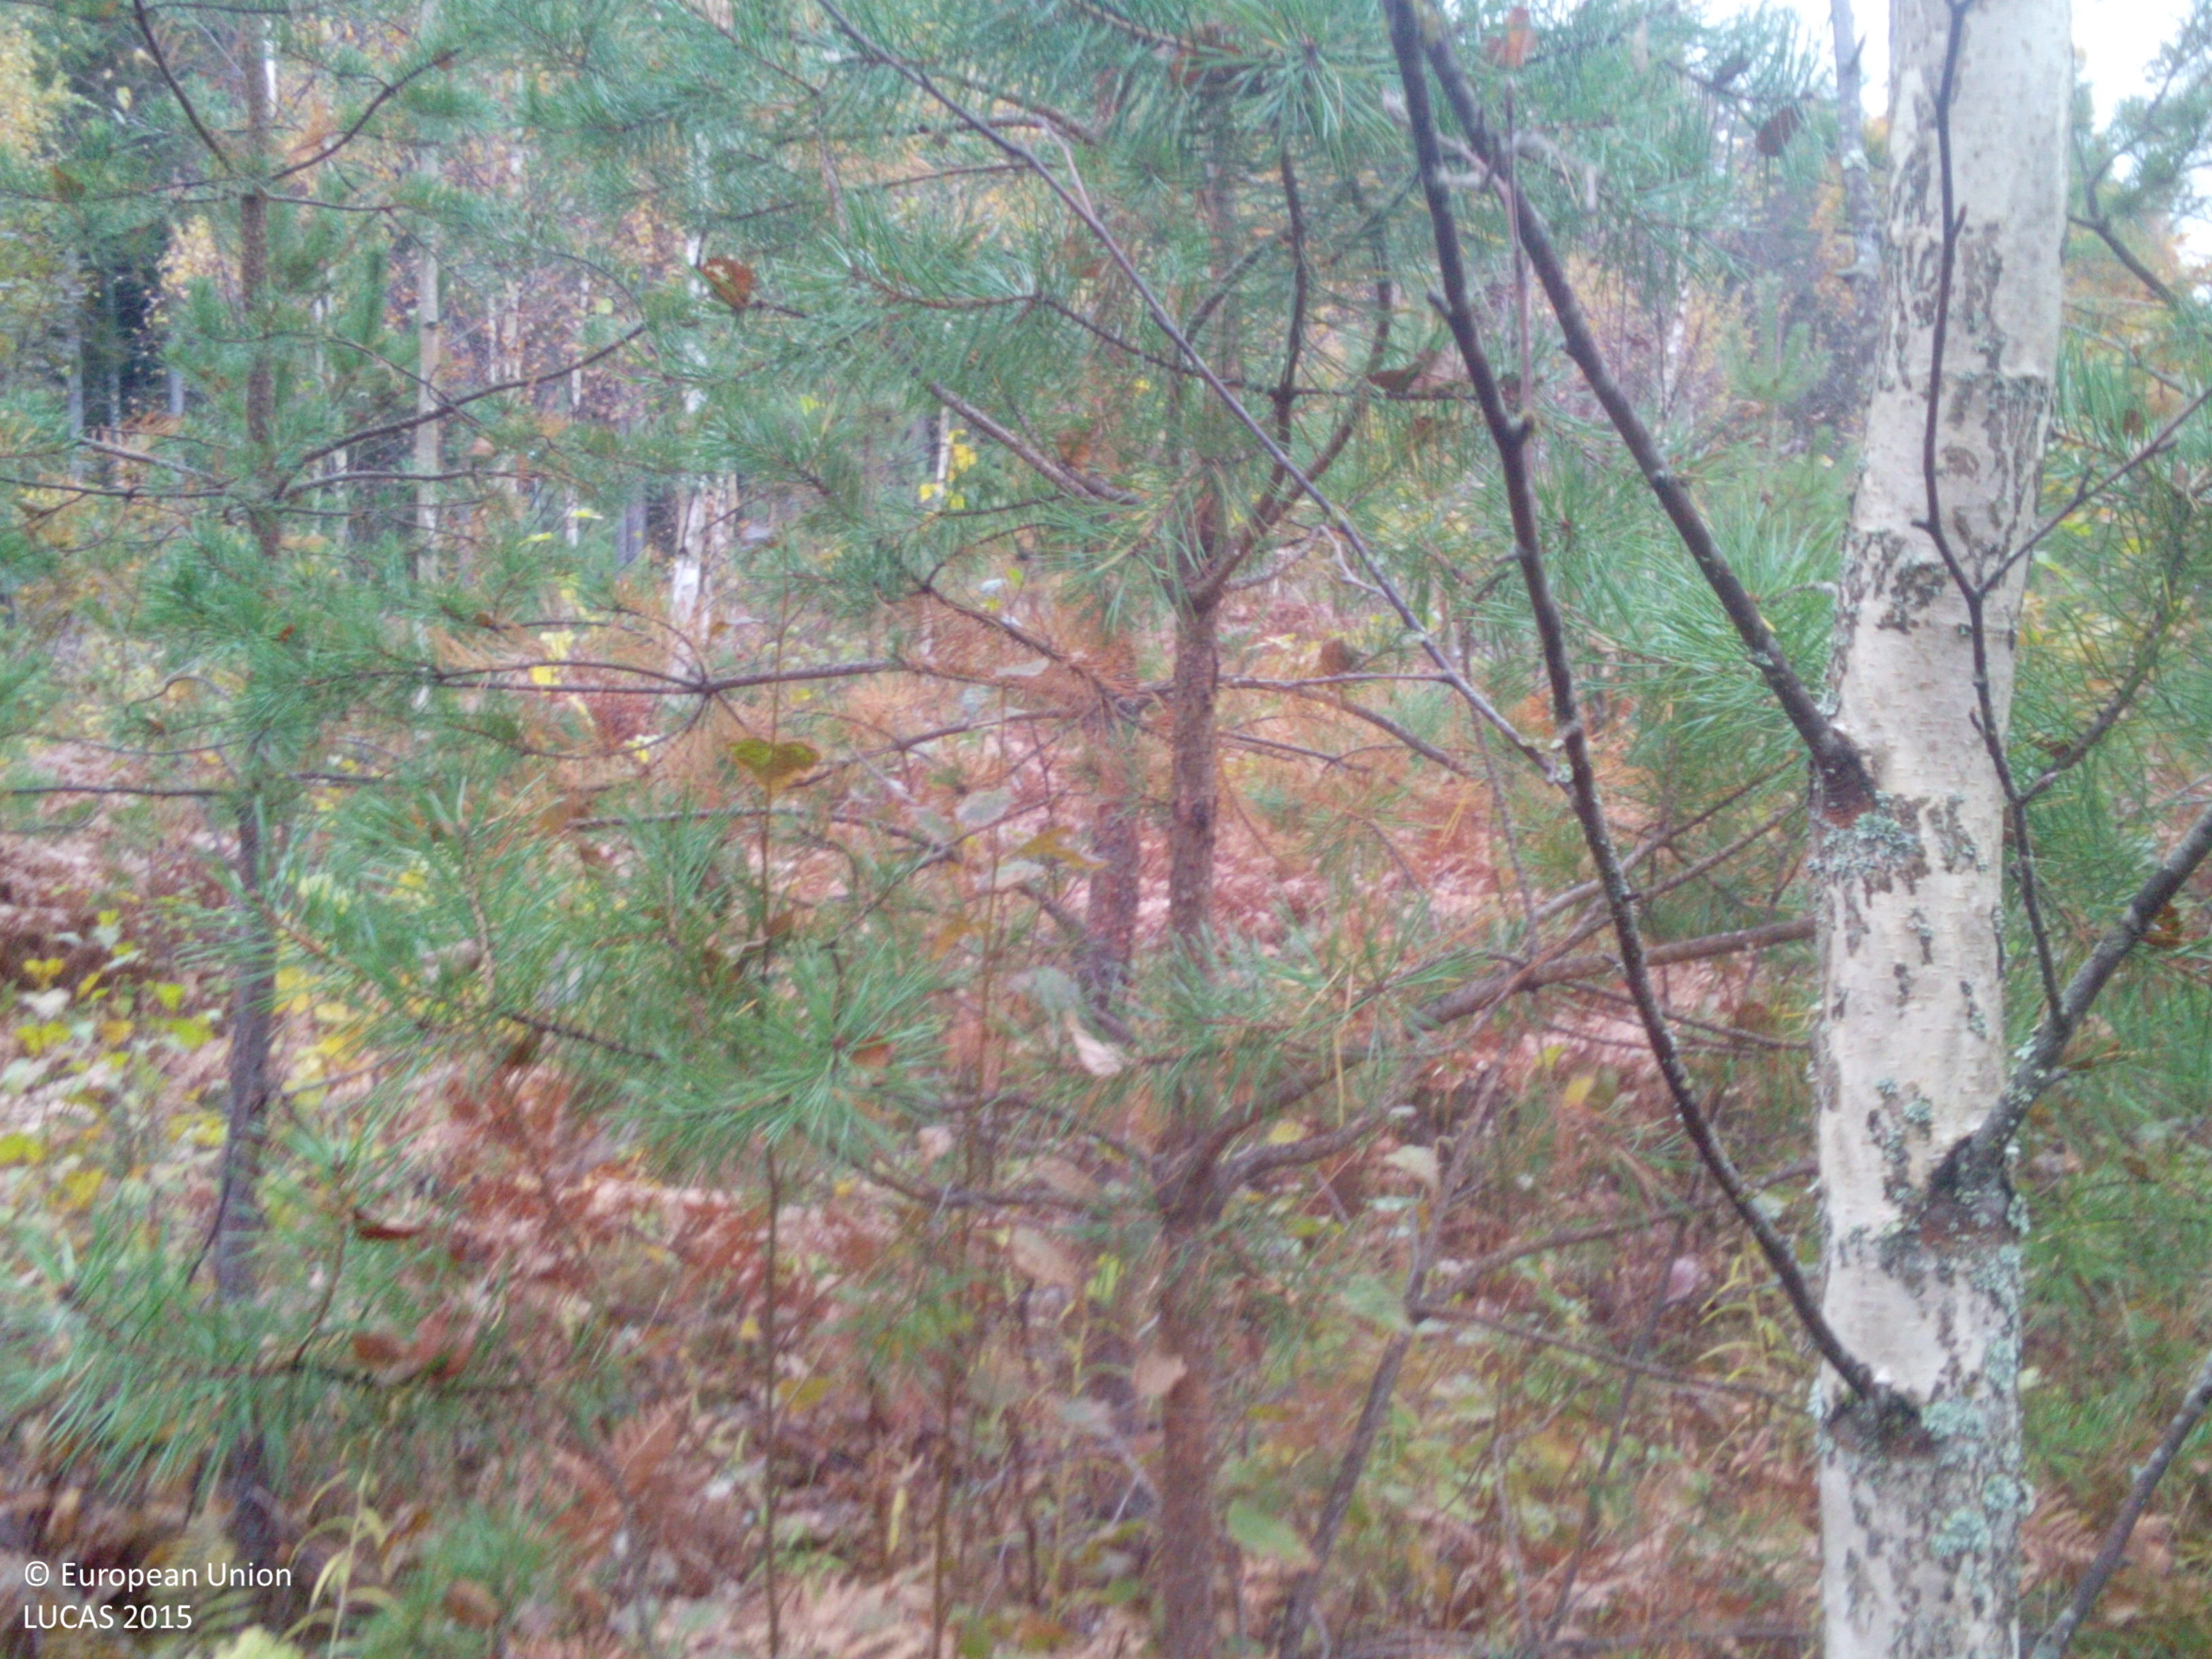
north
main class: Woodland
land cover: Pine dominated mixed woodland
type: boreal forest
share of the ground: > 75 %
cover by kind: coniferous forest trees 55 %, broadleaved forest trees 30 %, herbaceous plants 15 %
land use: Forestry
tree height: > 5 m
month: October
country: SE
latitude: 58.9561
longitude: 16.3049
